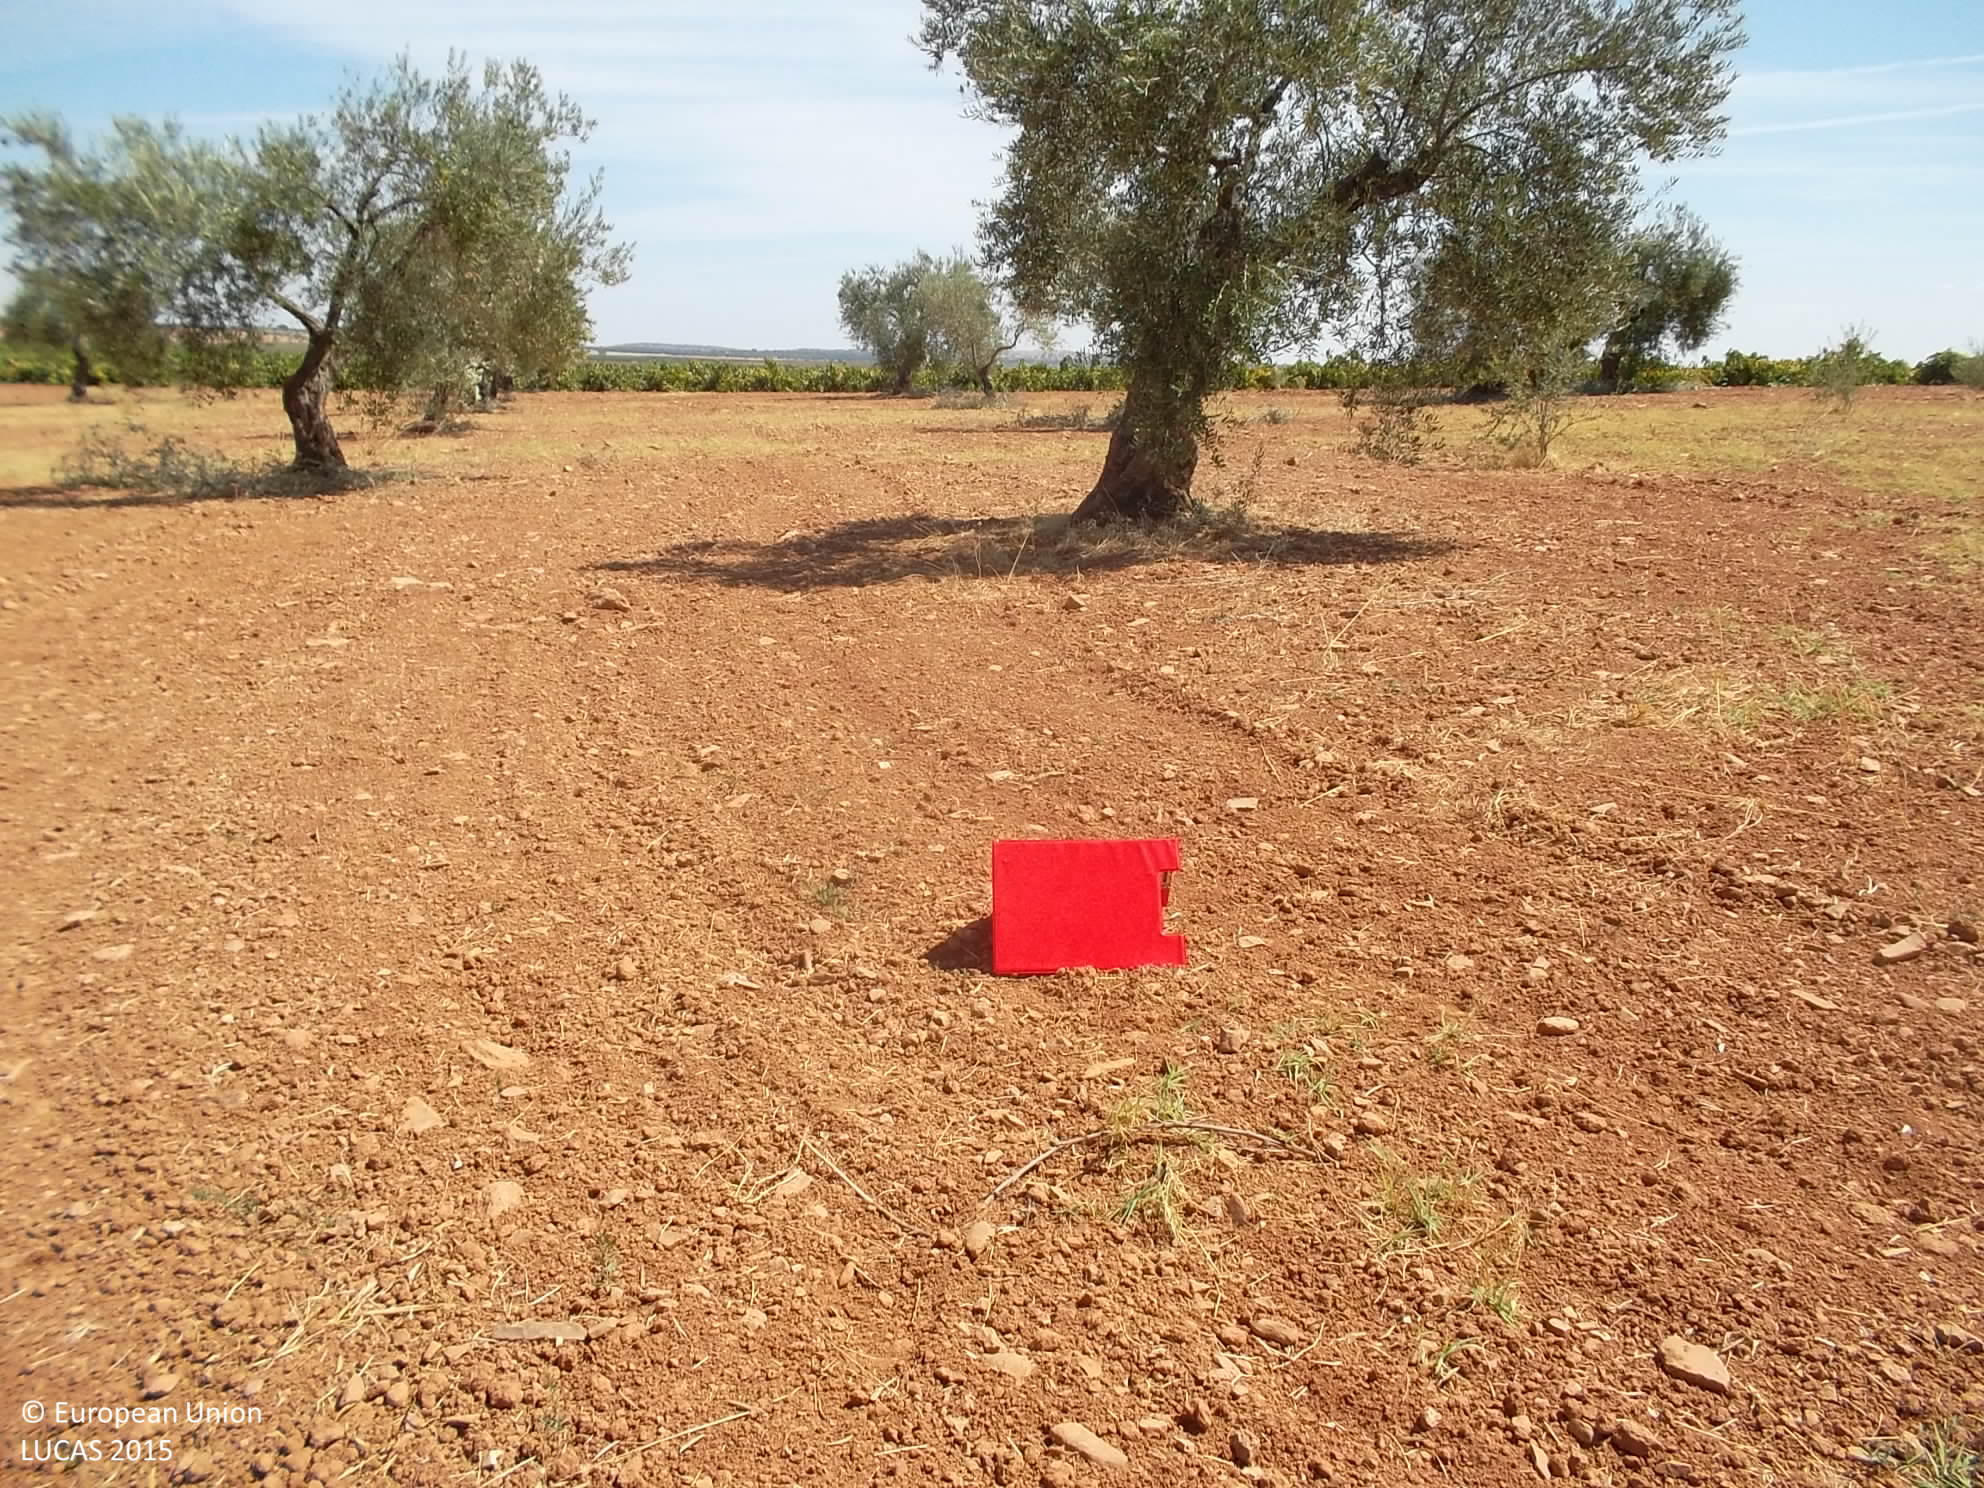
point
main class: Cropland
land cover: Olive groves
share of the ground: 10 - 25 %
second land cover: Other bare soil
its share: > 75 %
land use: Agriculture (excluding fallow land and kitchen gardens)
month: September
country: ES
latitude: 38.3580
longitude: -6.3089
